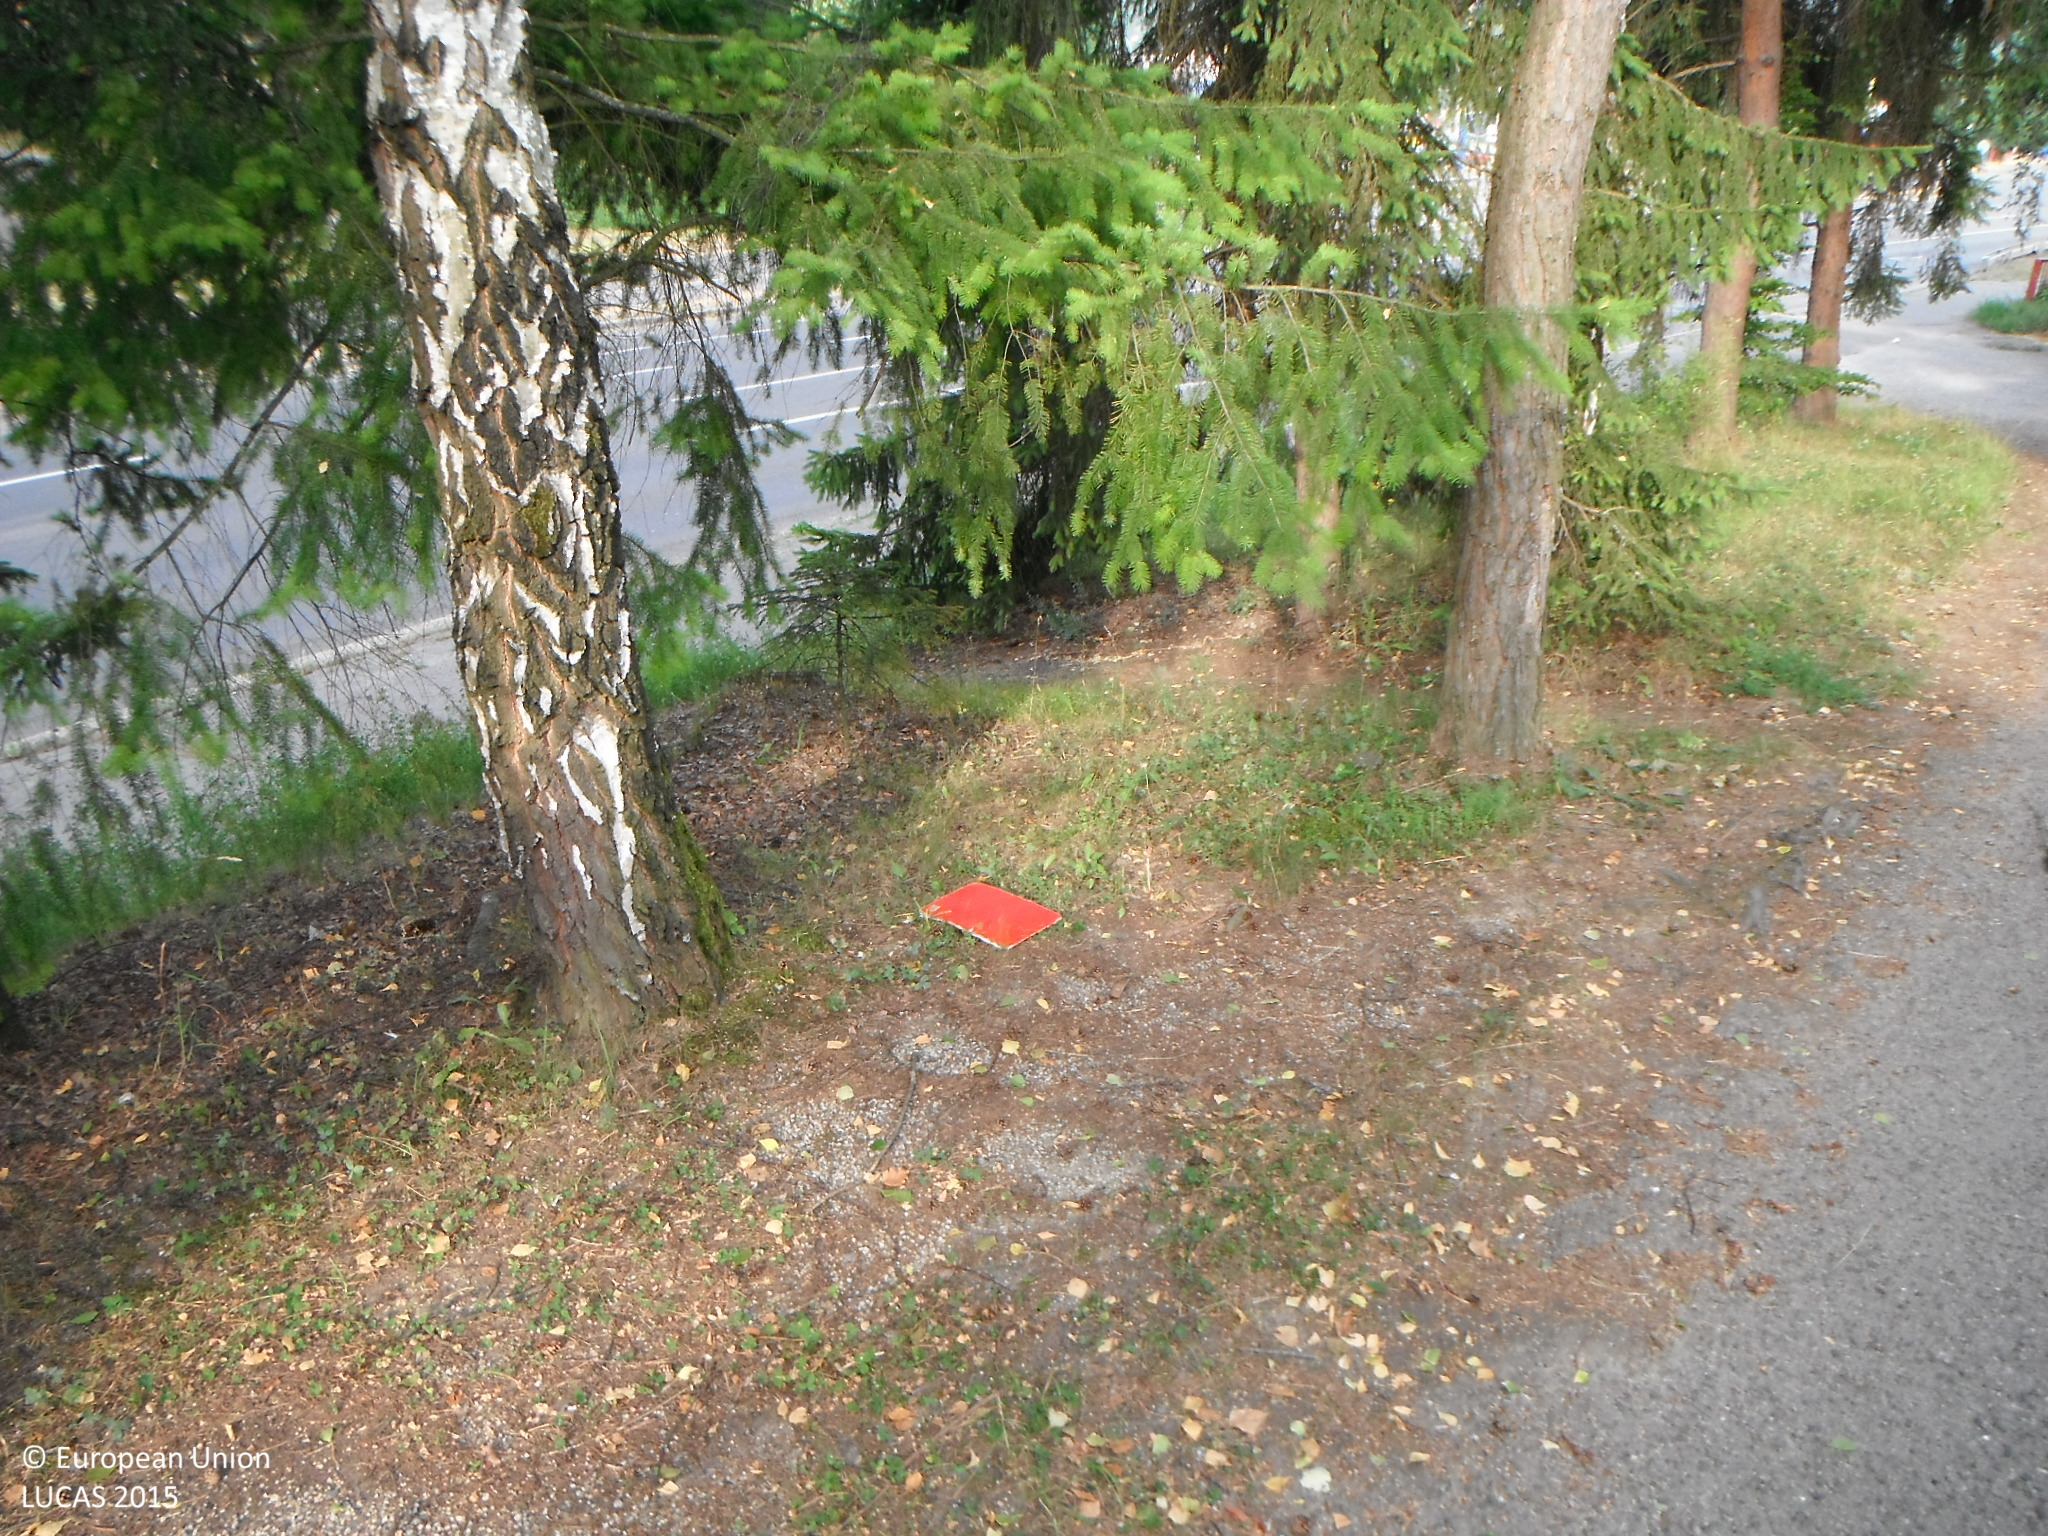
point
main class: Woodland
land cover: Other mixed woodland
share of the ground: > 75 %
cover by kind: coniferous forest trees 50 %, broadleaved forest trees 50 %
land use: Residential
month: July
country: SK
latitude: 48.5695
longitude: 19.1152
